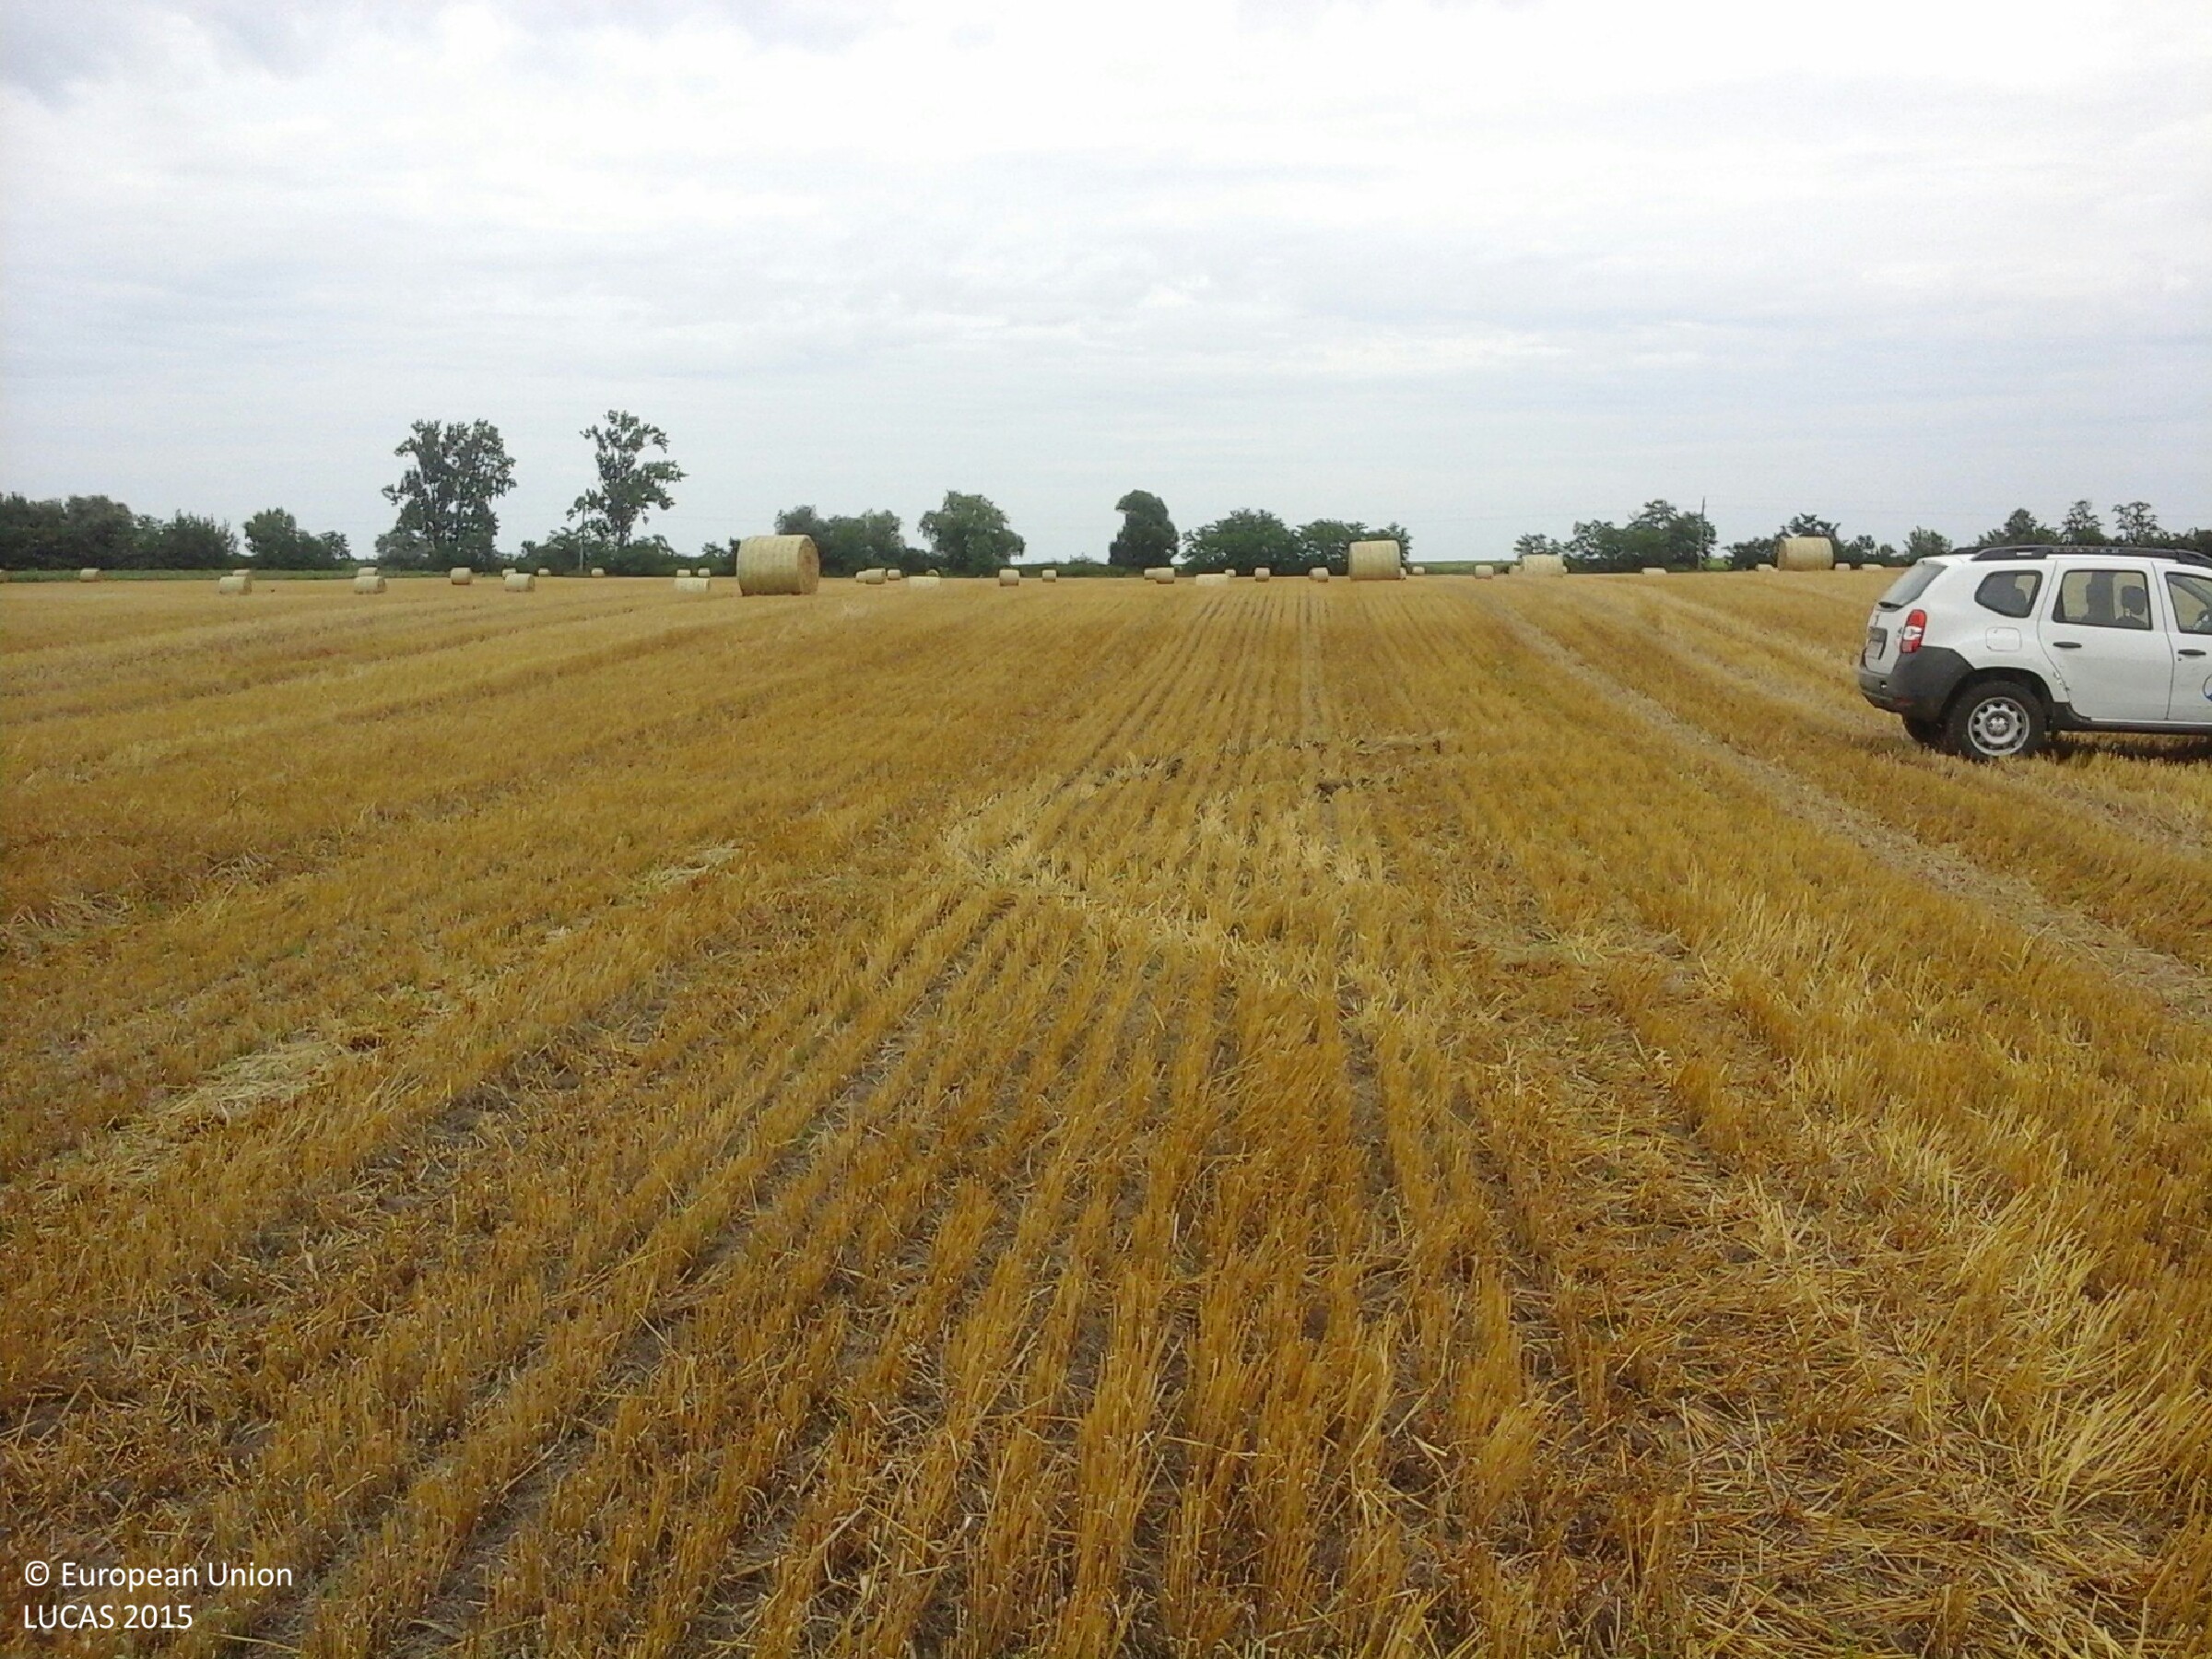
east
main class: Cropland
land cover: Common wheat
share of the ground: 25 - 50 %
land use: Agriculture (excluding fallow land and kitchen gardens)
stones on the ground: < 10 %
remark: Harvested field
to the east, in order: Common wheat
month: July
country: HU
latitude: 47.4483
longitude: 20.8701
